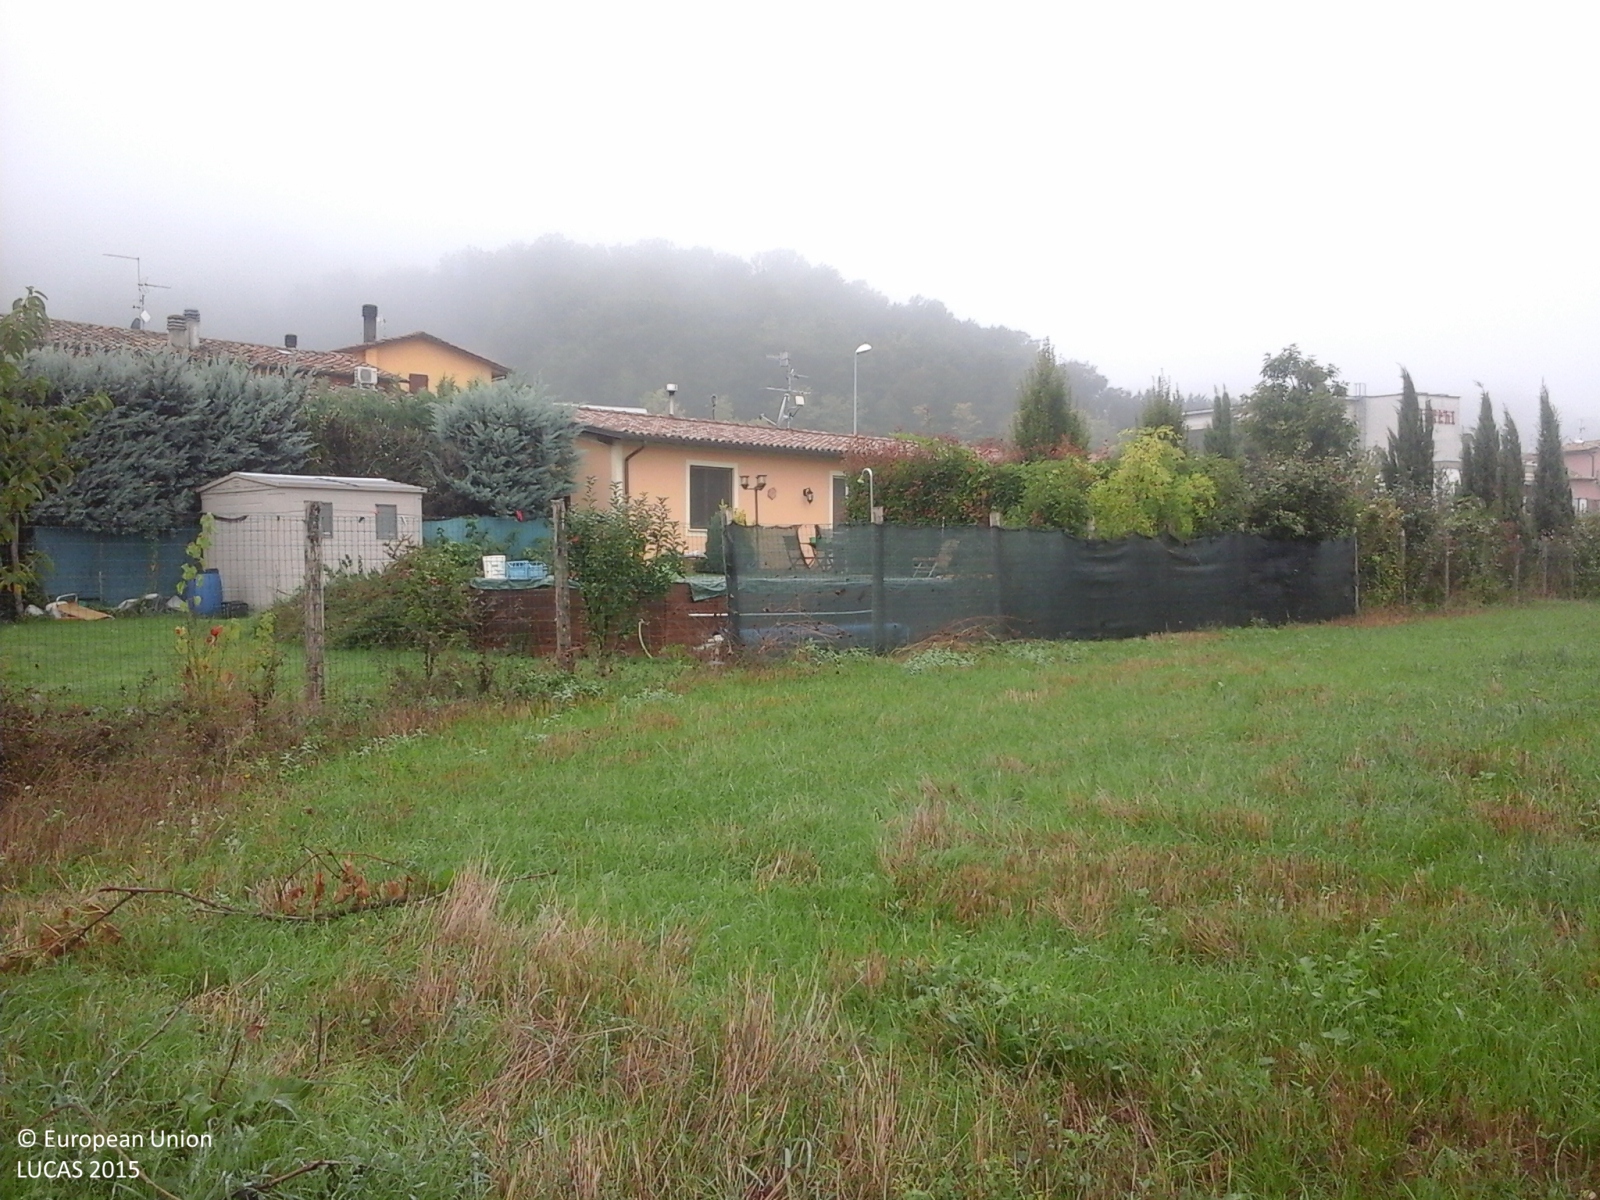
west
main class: Cropland
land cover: Tobacco
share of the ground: > 75 %
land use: Agriculture (excluding fallow land and kitchen gardens)
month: October
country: IT
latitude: 43.5170
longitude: 12.1098
